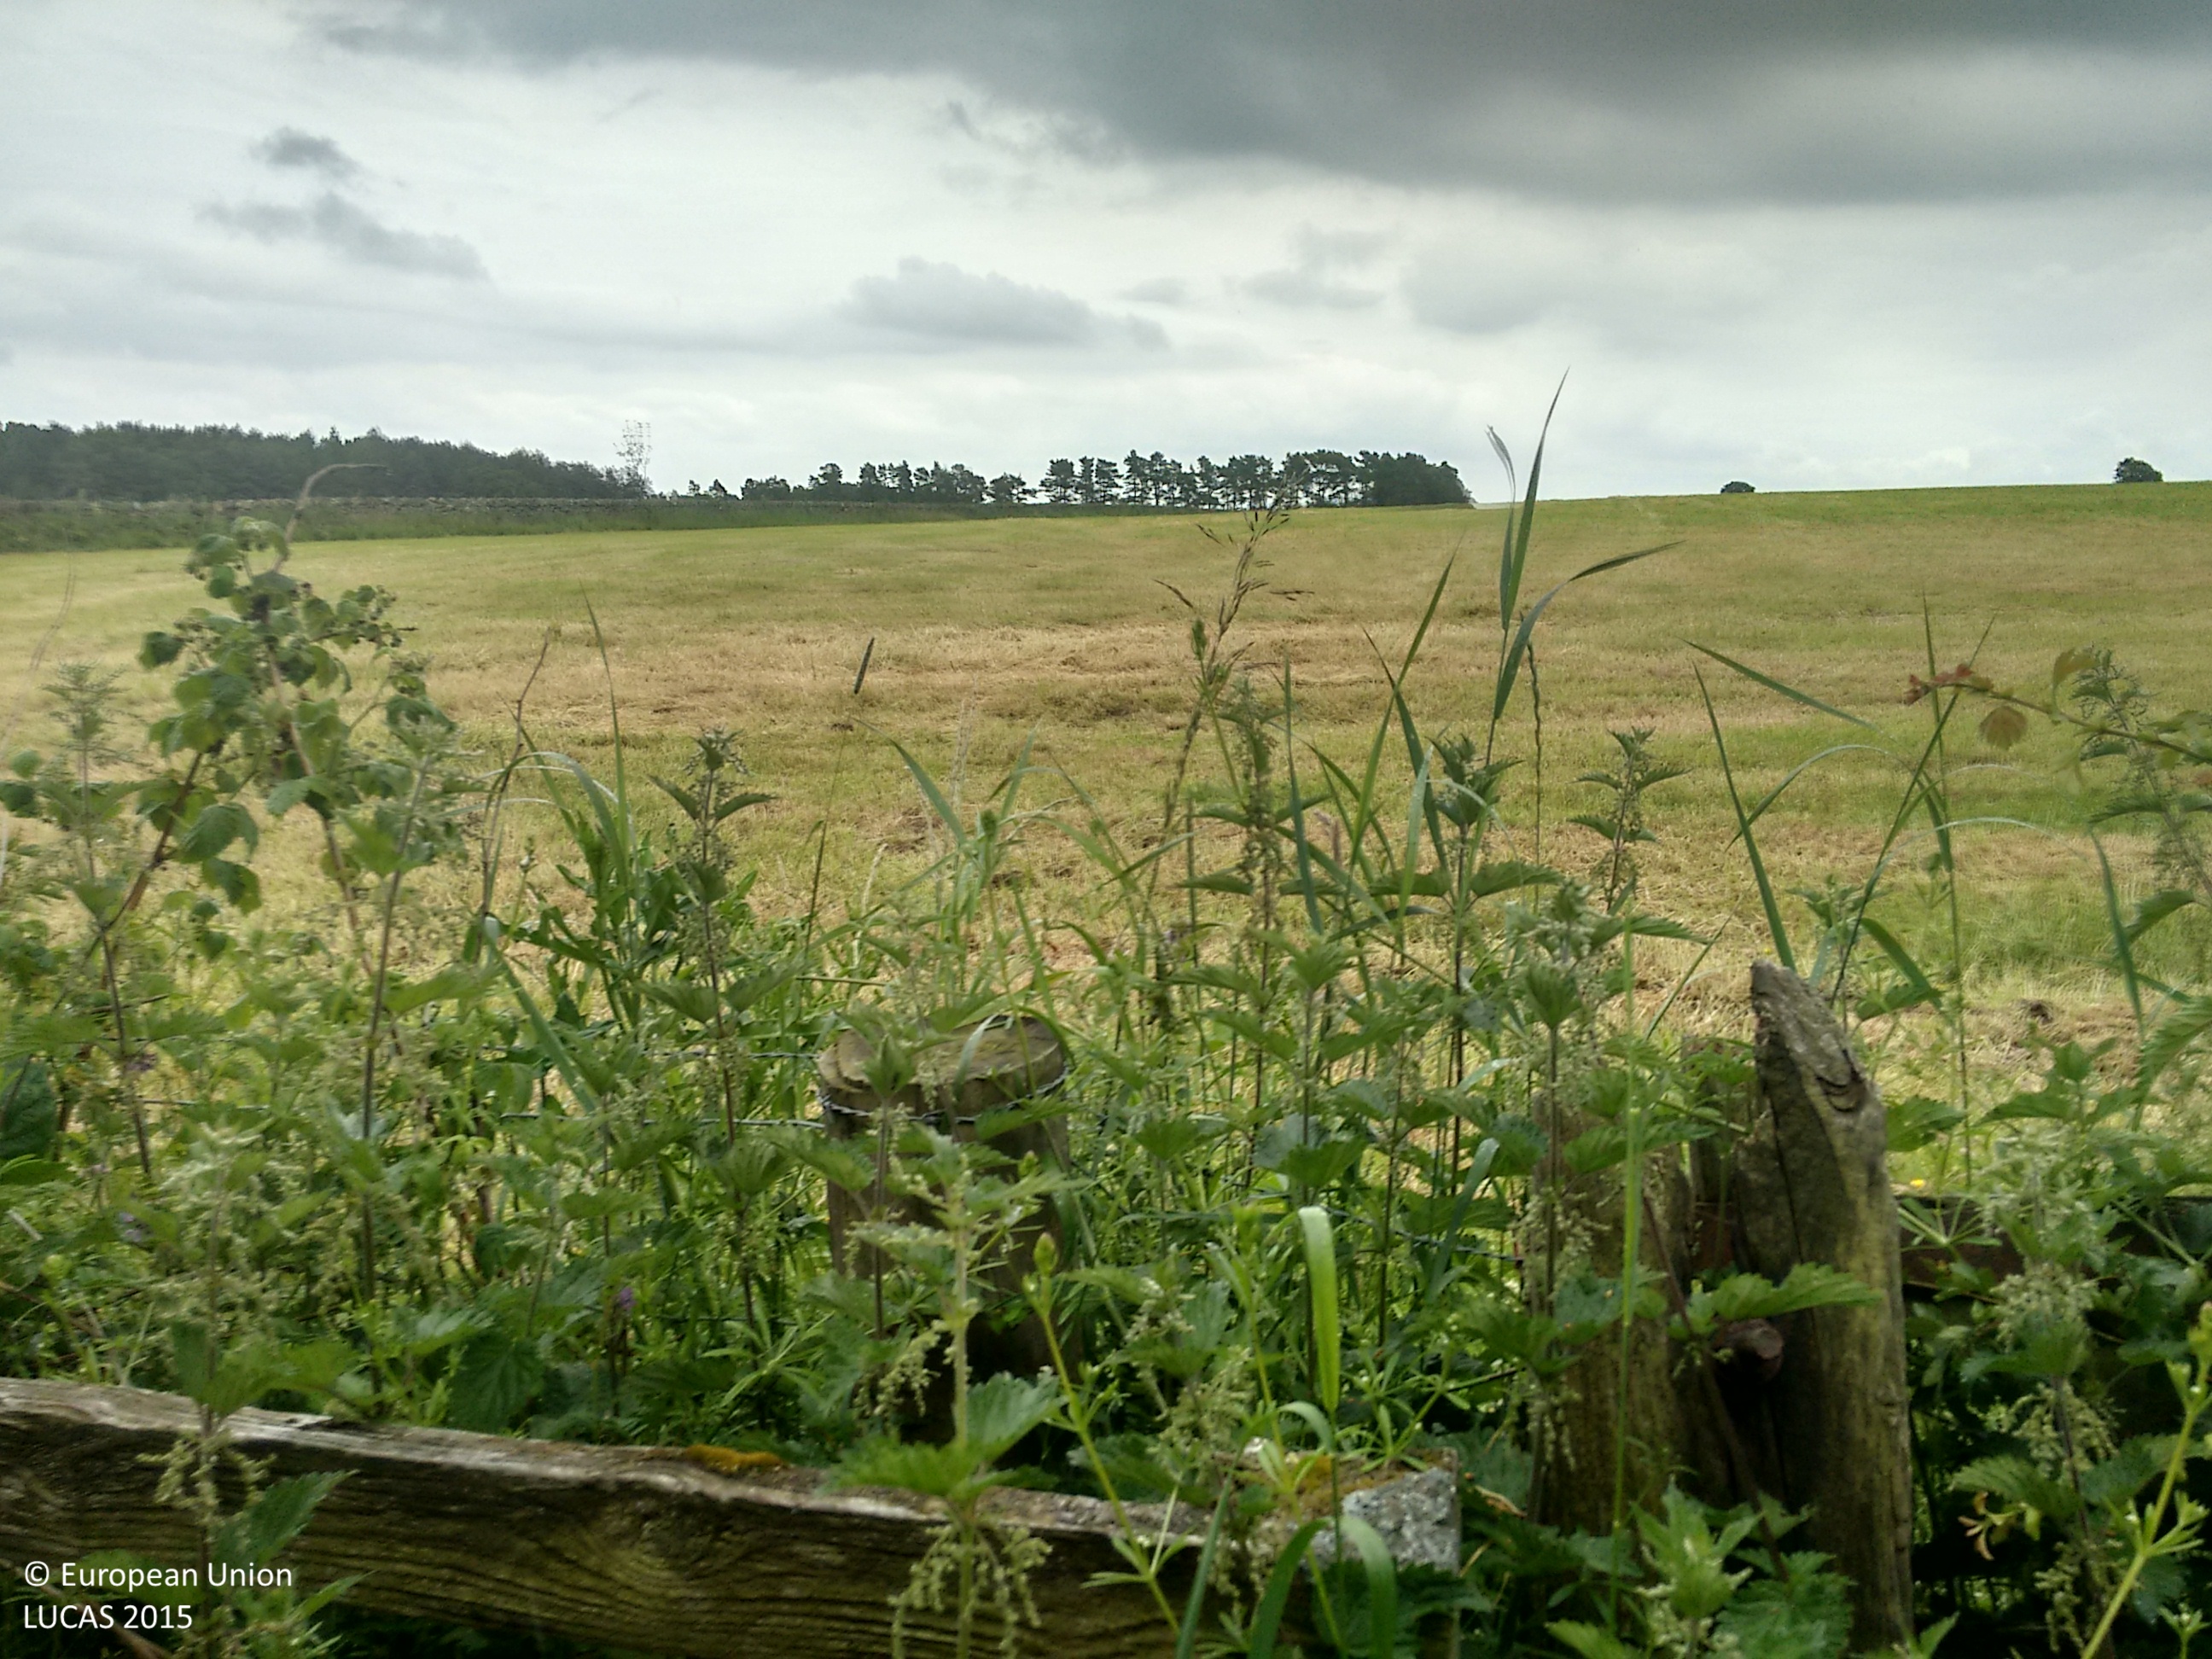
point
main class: Grassland
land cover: Grassland without tree/shrub cover
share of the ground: > 75 %
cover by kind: herbaceous plants 100 %
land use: Agriculture (excluding fallow land and kitchen gardens)
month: July
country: GB
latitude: 54.6159
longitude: -1.8688
